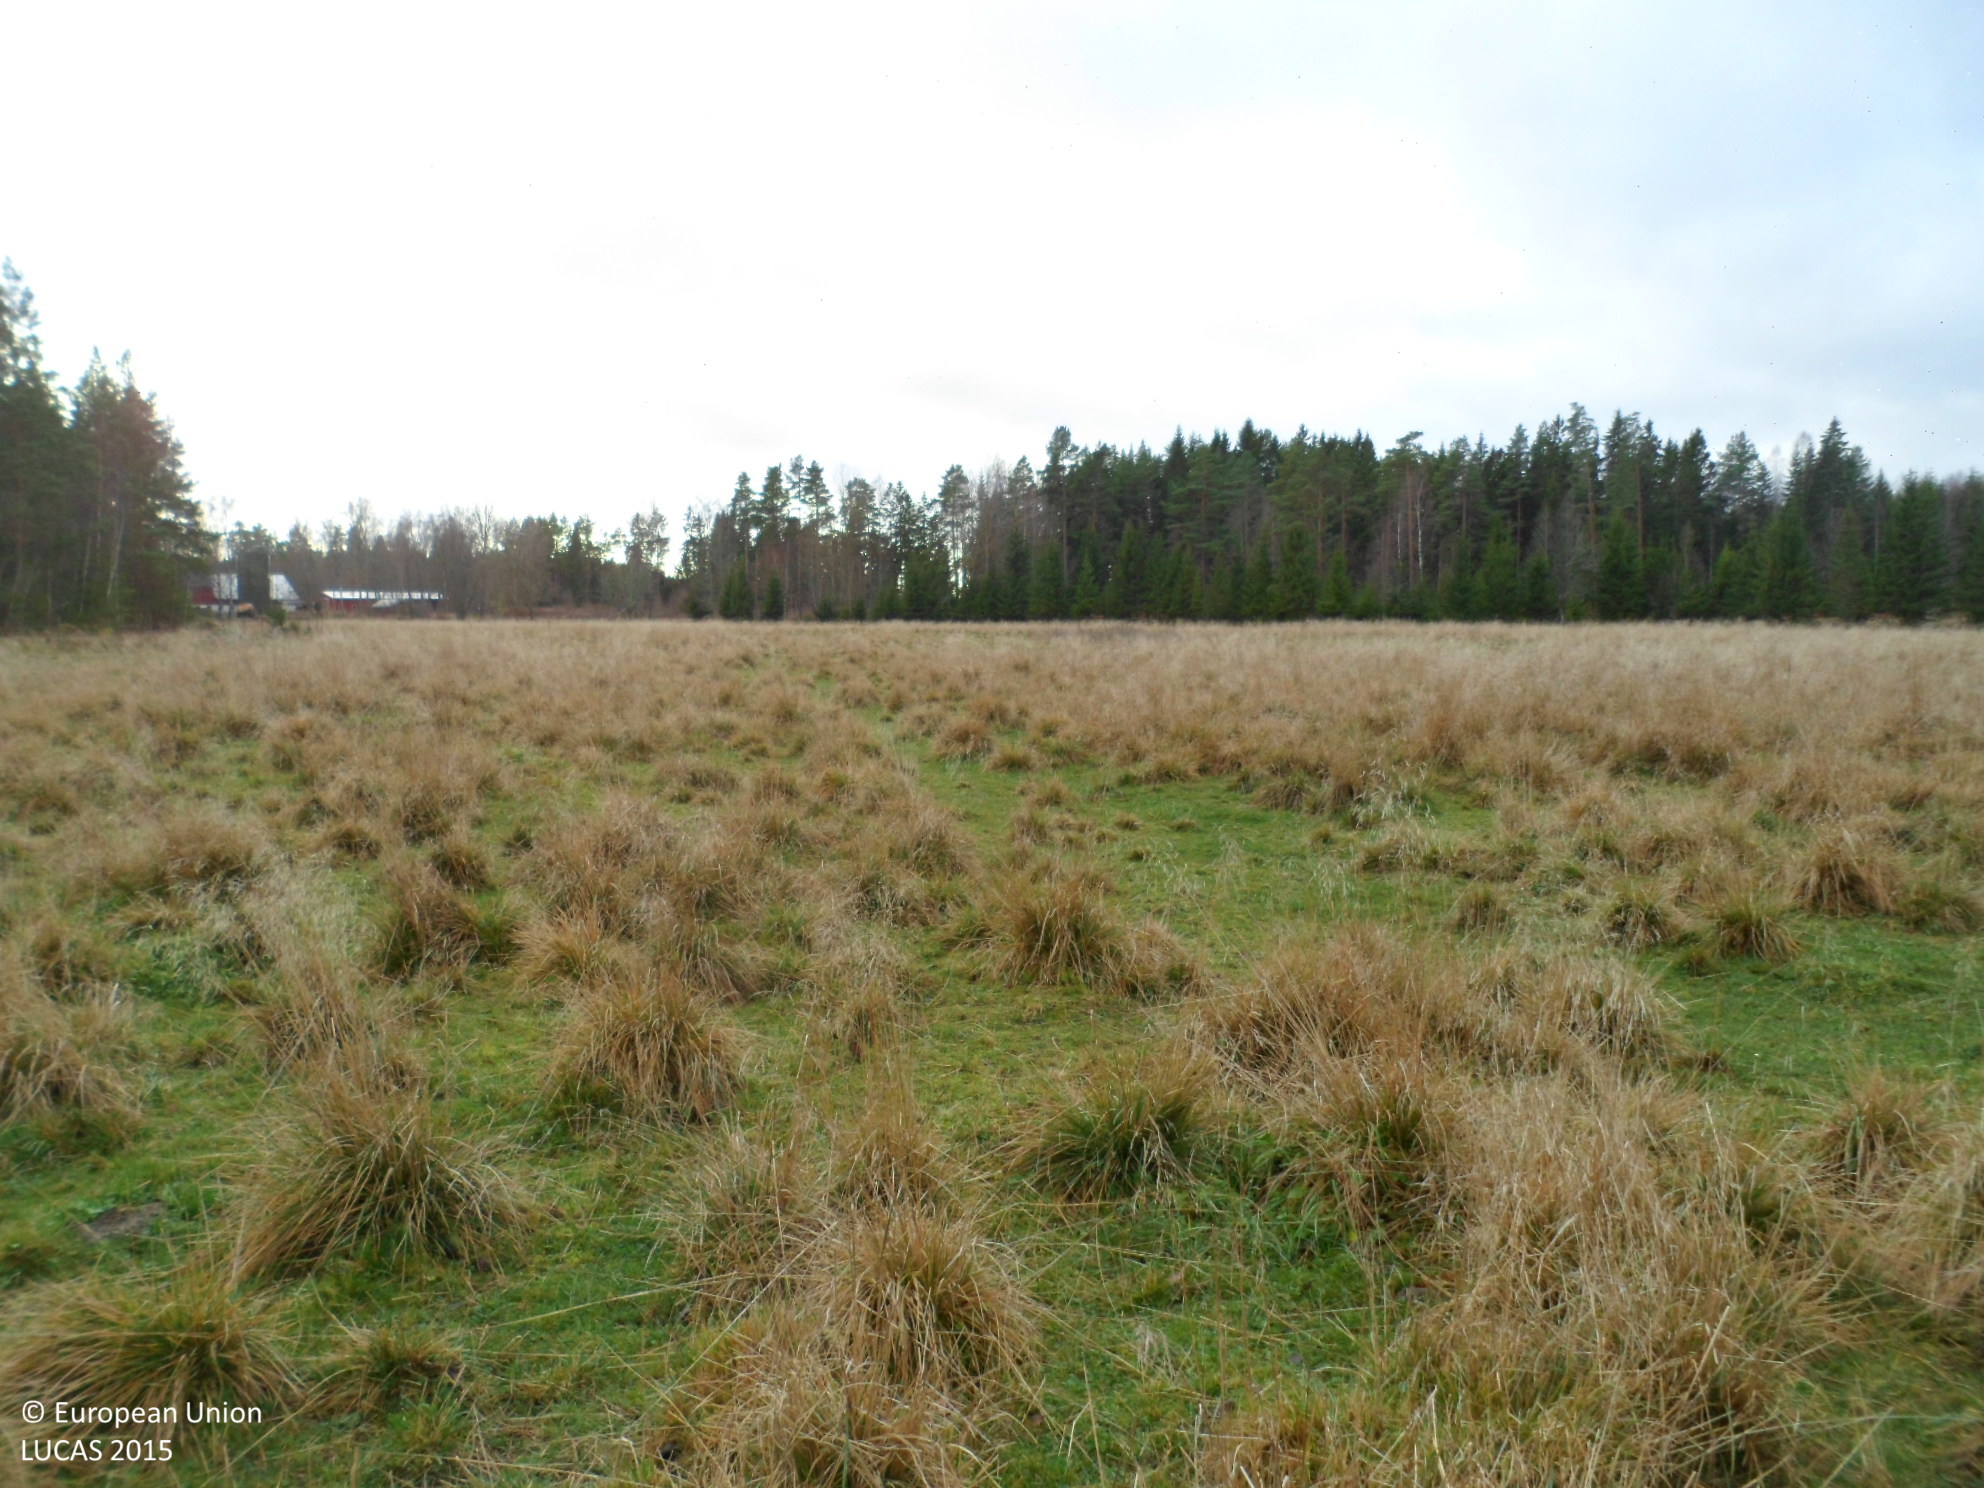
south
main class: Grassland
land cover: Grassland without tree/shrub cover
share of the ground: > 75 %
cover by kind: herbaceous plants 100 %
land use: Agriculture (excluding fallow land and kitchen gardens)
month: November
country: SE
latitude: 57.4774
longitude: 15.8846
